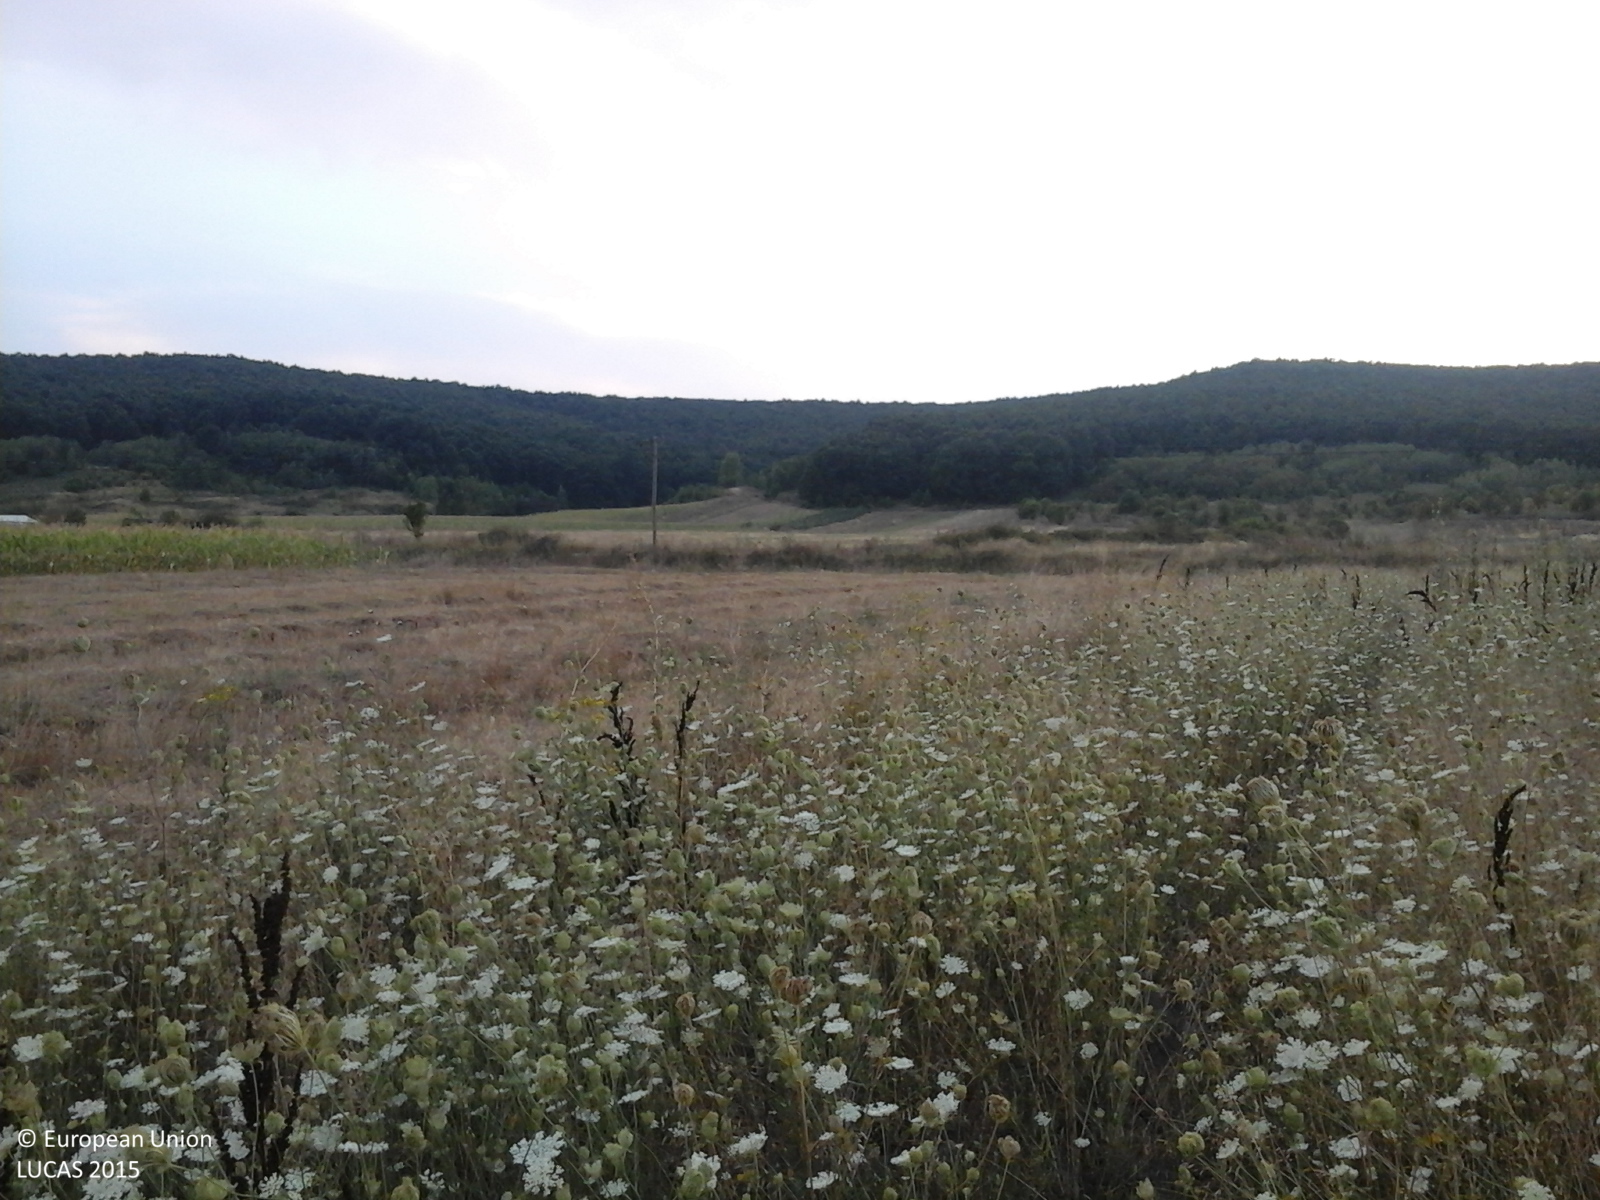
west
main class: Grassland
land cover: Spontaneously vegetated surfaces
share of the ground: > 75 %
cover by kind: herbaceous plants 100 %
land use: Fallow land
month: August
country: RO
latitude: 44.6711
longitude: 23.8990
